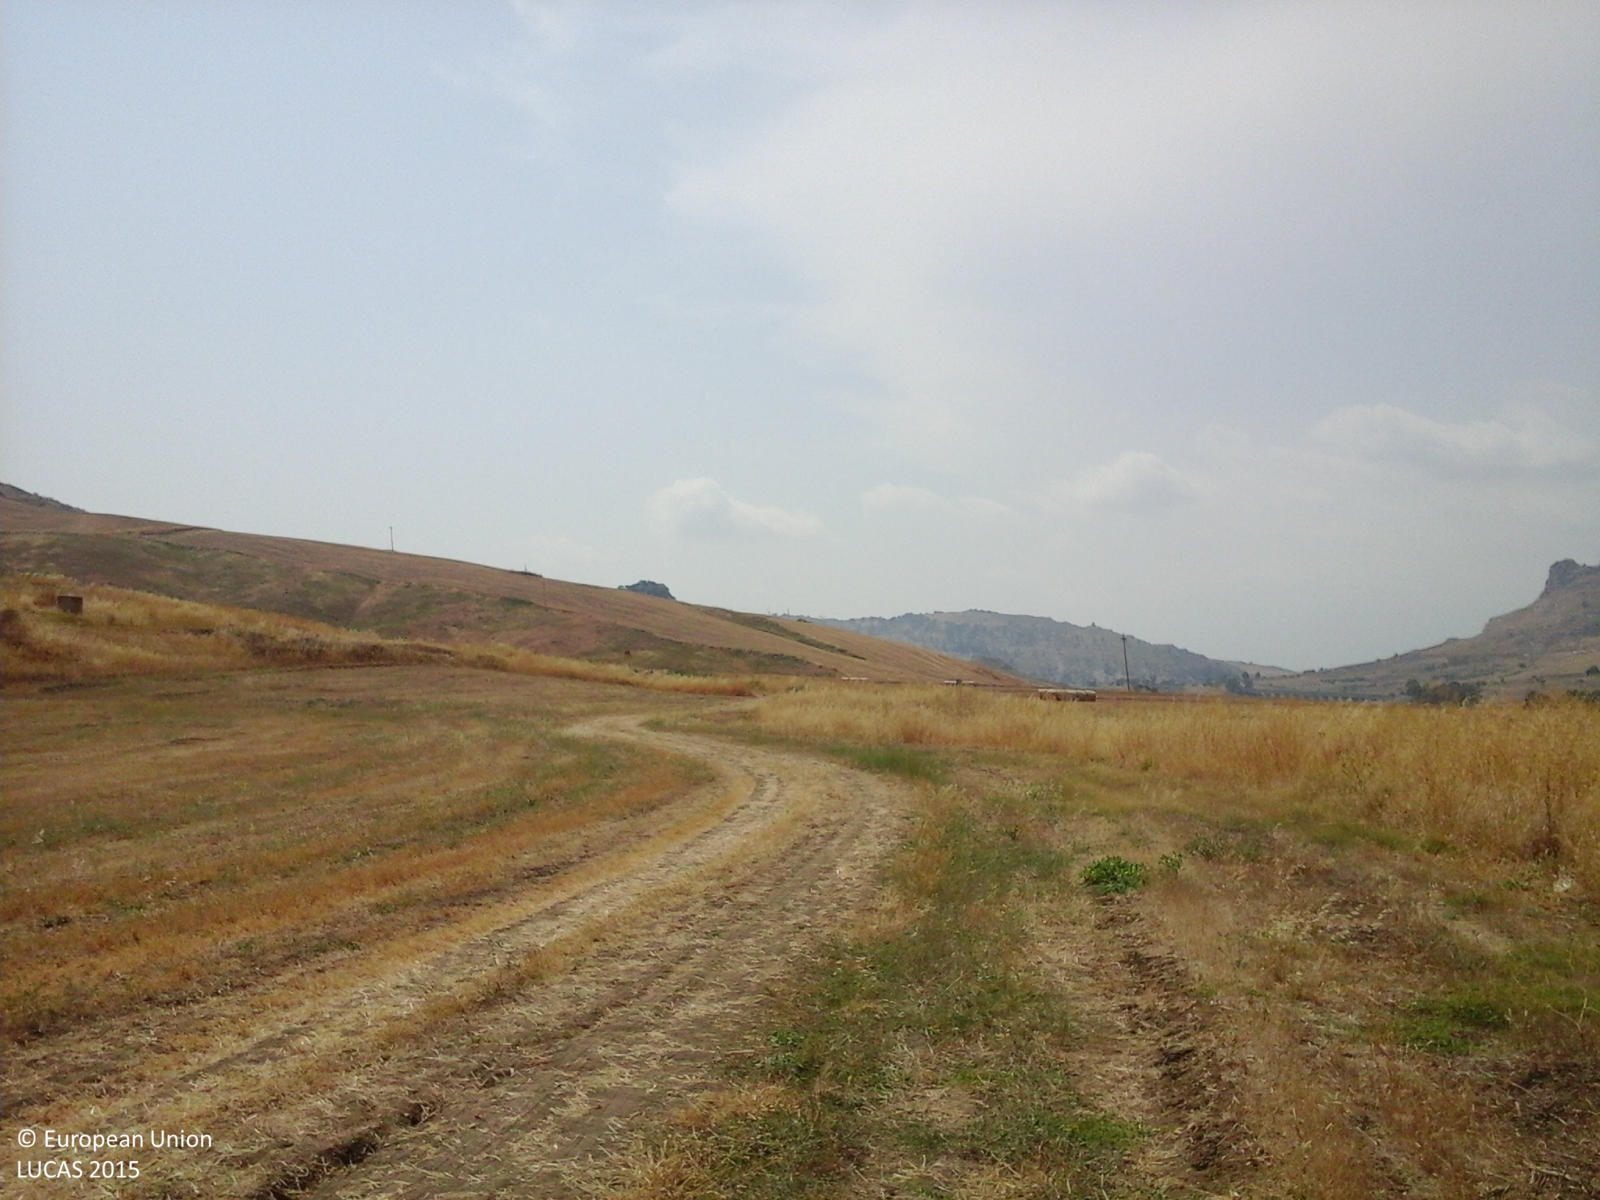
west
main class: Grassland
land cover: Grassland without tree/shrub cover
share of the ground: > 75 %
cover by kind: herbaceous plants 100 %
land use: Agriculture (excluding fallow land and kitchen gardens)
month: July
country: IT
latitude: 37.2809
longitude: 14.0180
